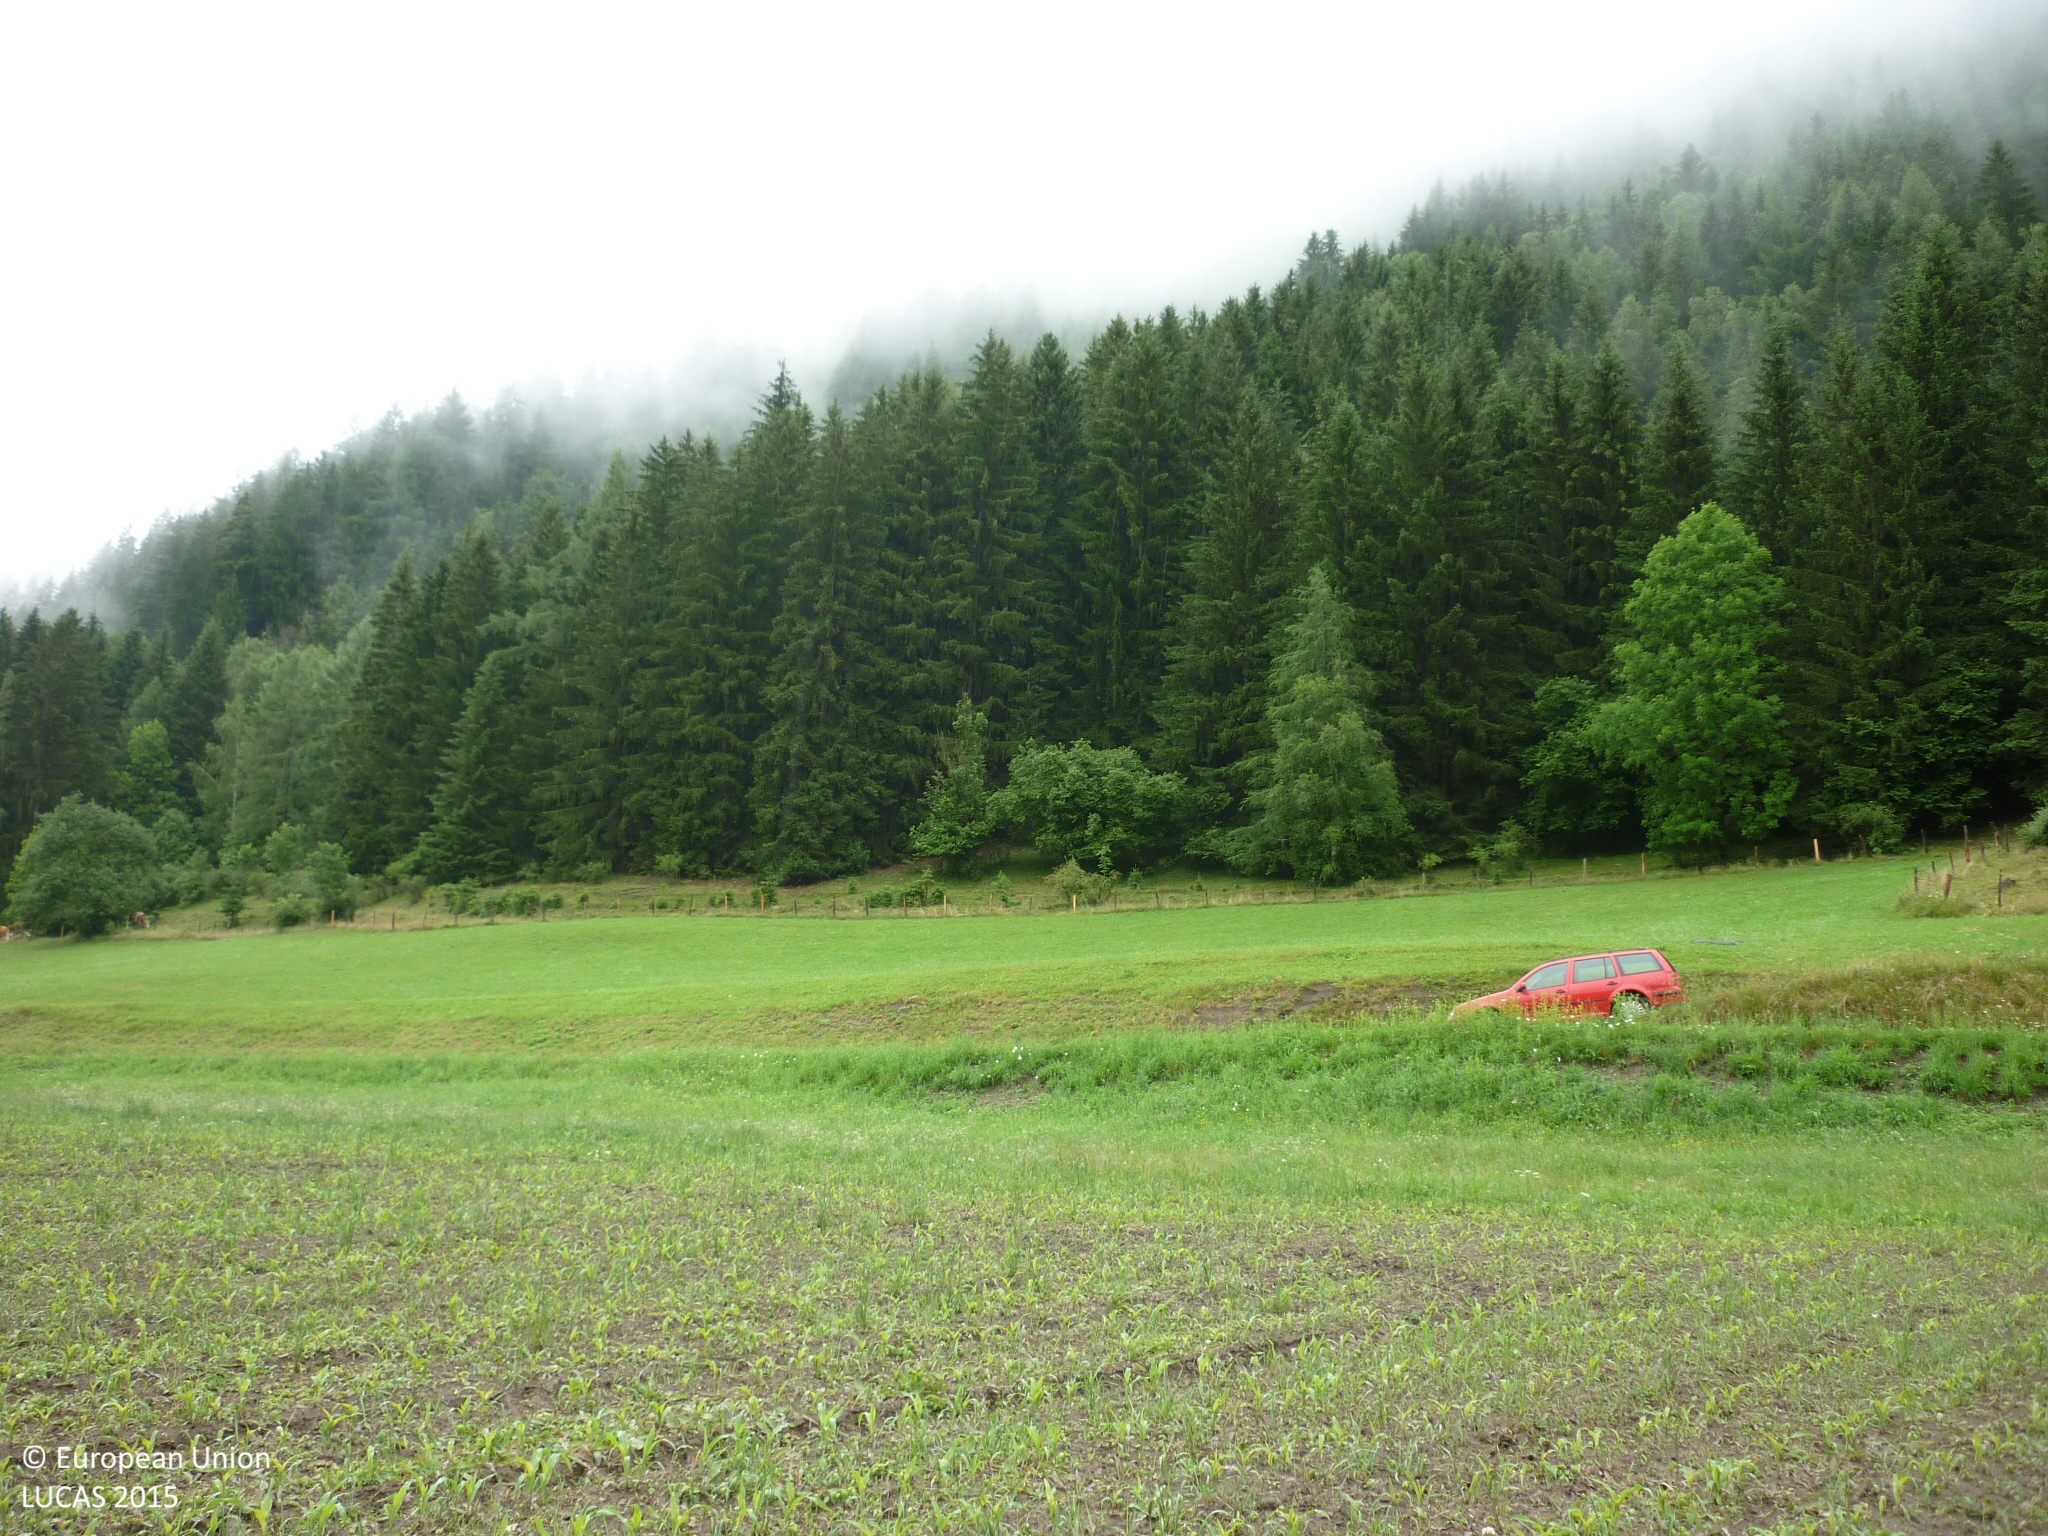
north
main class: Cropland
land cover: Maize
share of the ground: 25 - 50 %
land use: Agriculture (excluding fallow land and kitchen gardens)
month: June
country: AT
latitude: 47.1638
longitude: 14.3648
